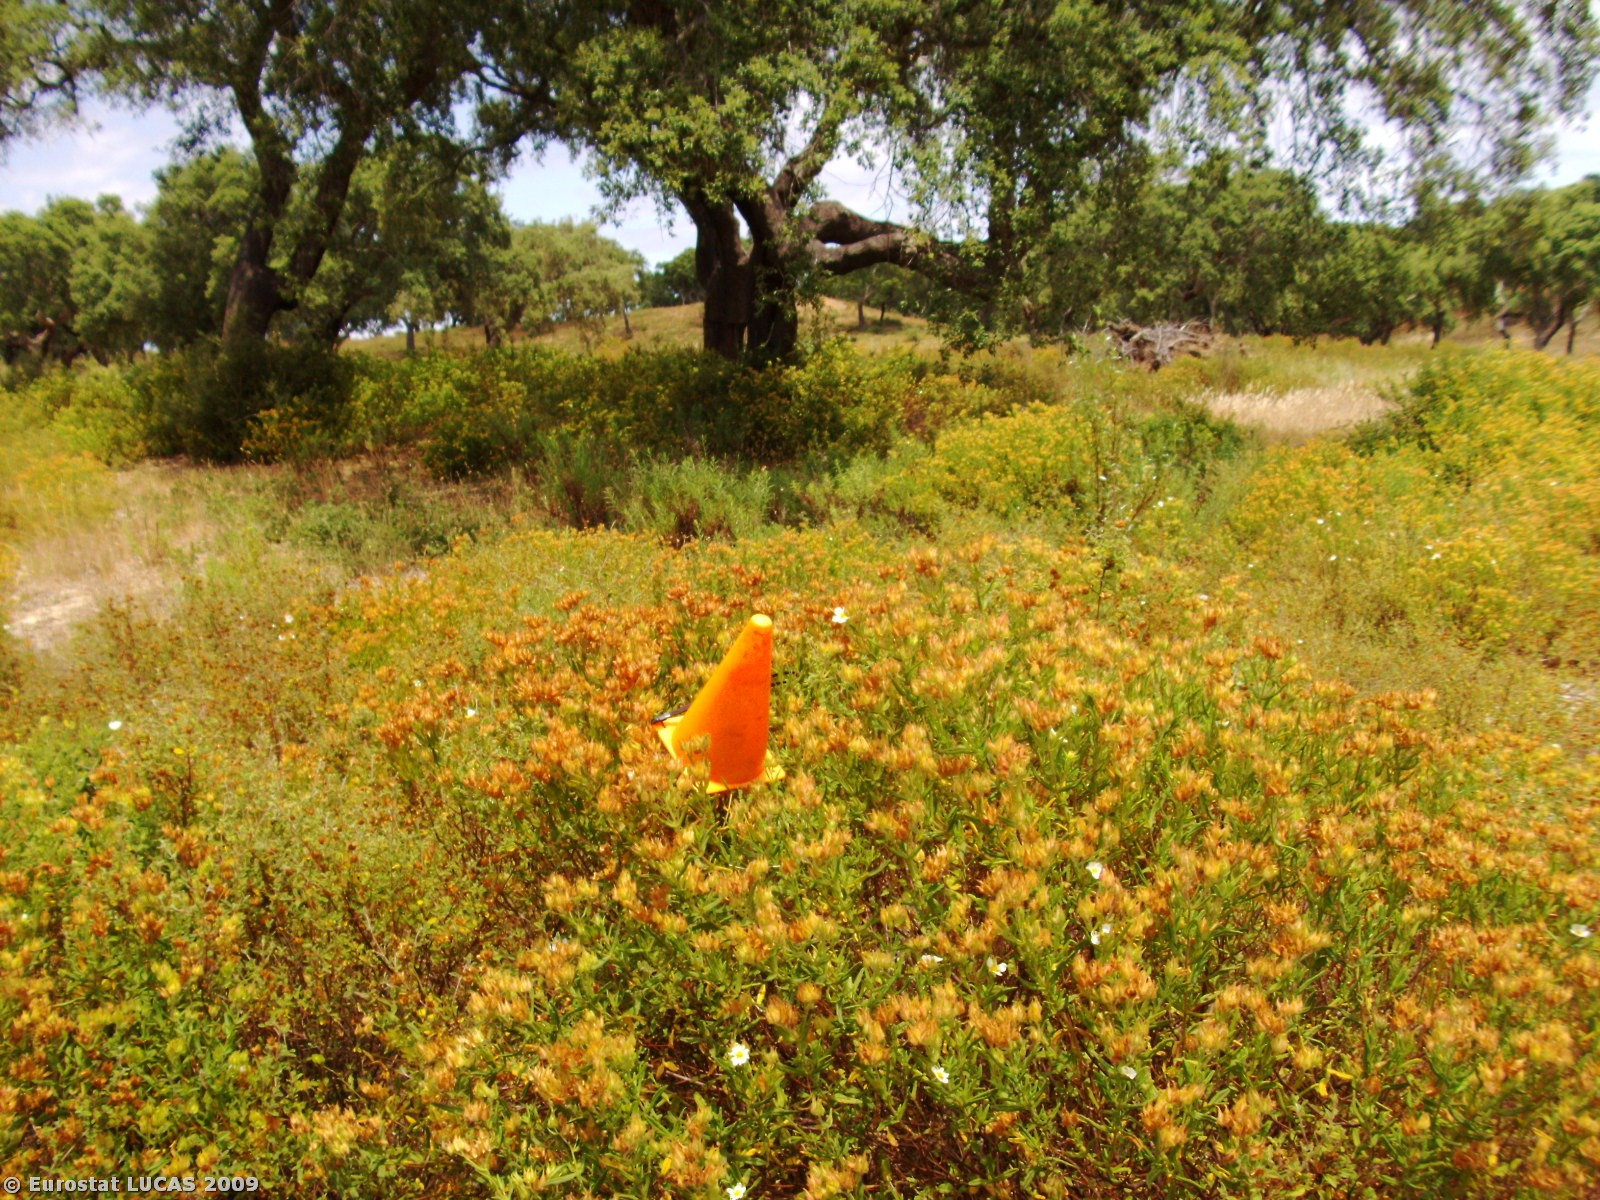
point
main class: Woodland
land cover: Broadleaved woodland
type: broadleaved evergreen forest
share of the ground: 25 - 50 %
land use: Forestry
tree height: > 5 m
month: June
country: PT
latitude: 38.1090
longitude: -8.7442
